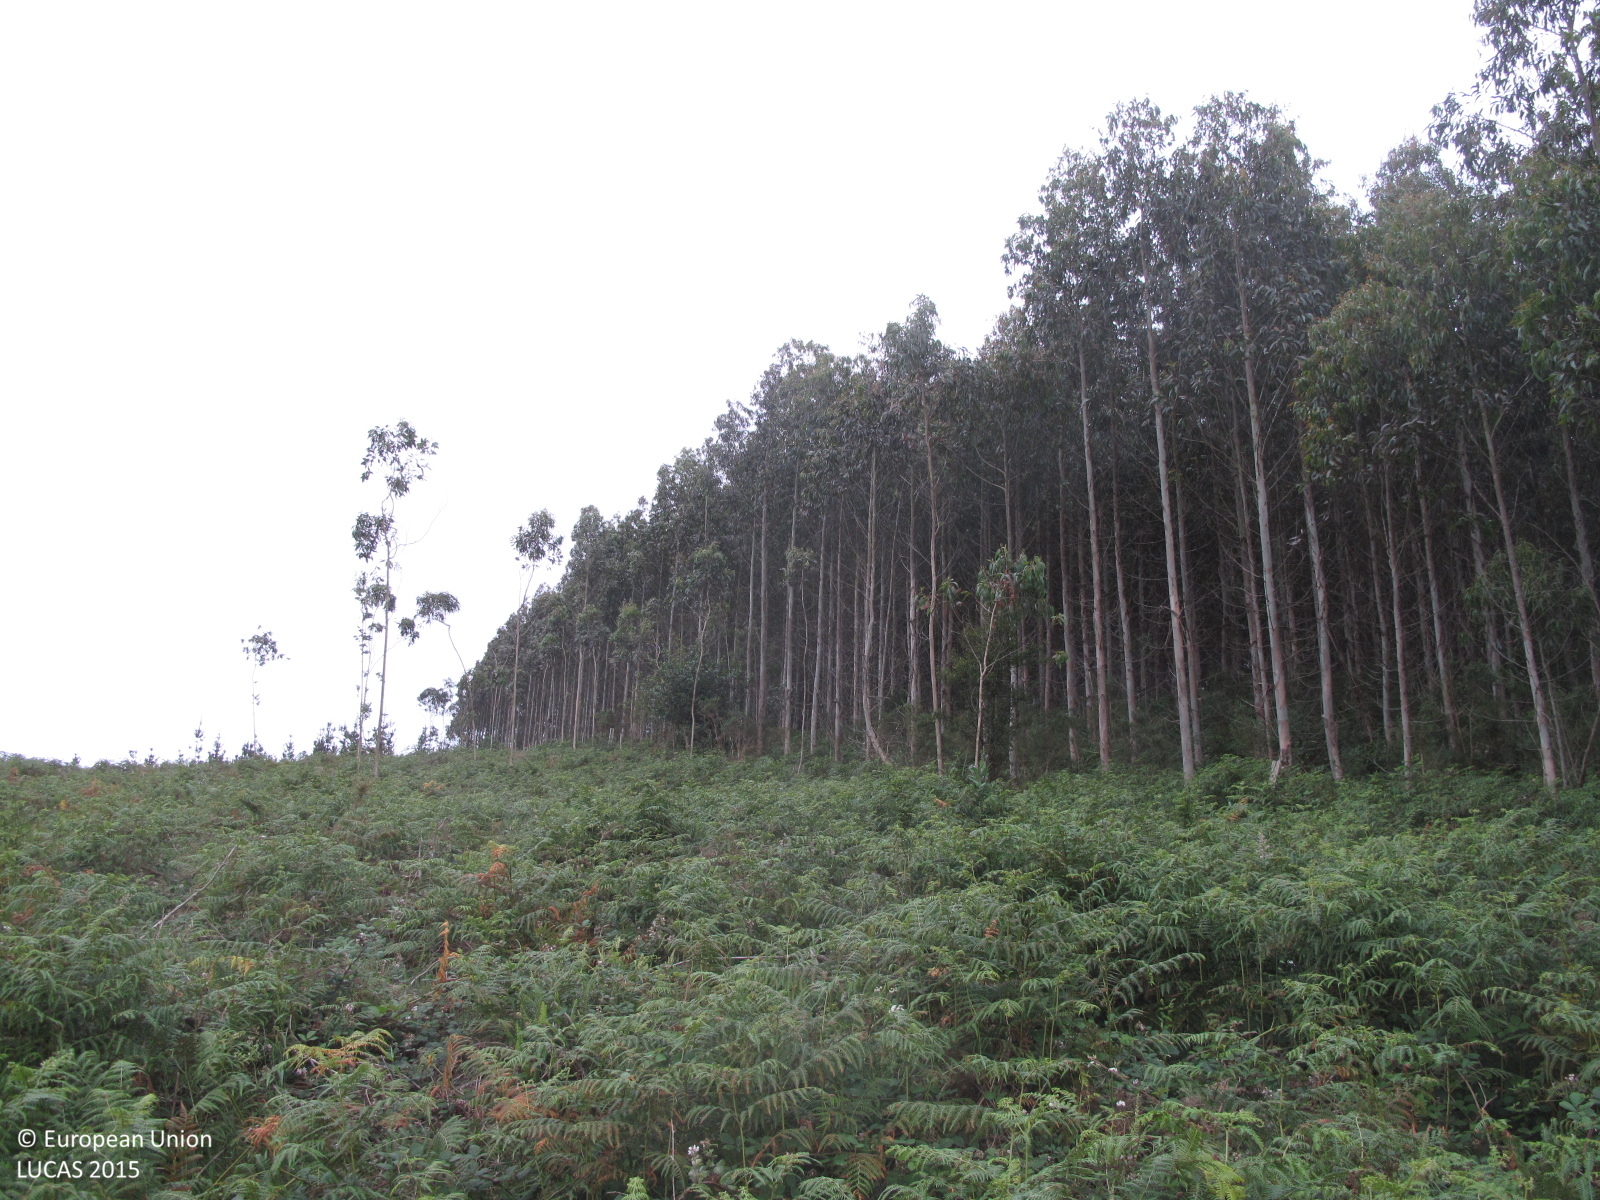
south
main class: Woodland
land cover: Broadleaved woodland
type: exotic forest
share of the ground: > 75 %
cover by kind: broadleaved forest trees 90 %, shrubs 10 %
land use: Forestry
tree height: > 5 m
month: July
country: ES
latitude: 43.7177
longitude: -7.9074
